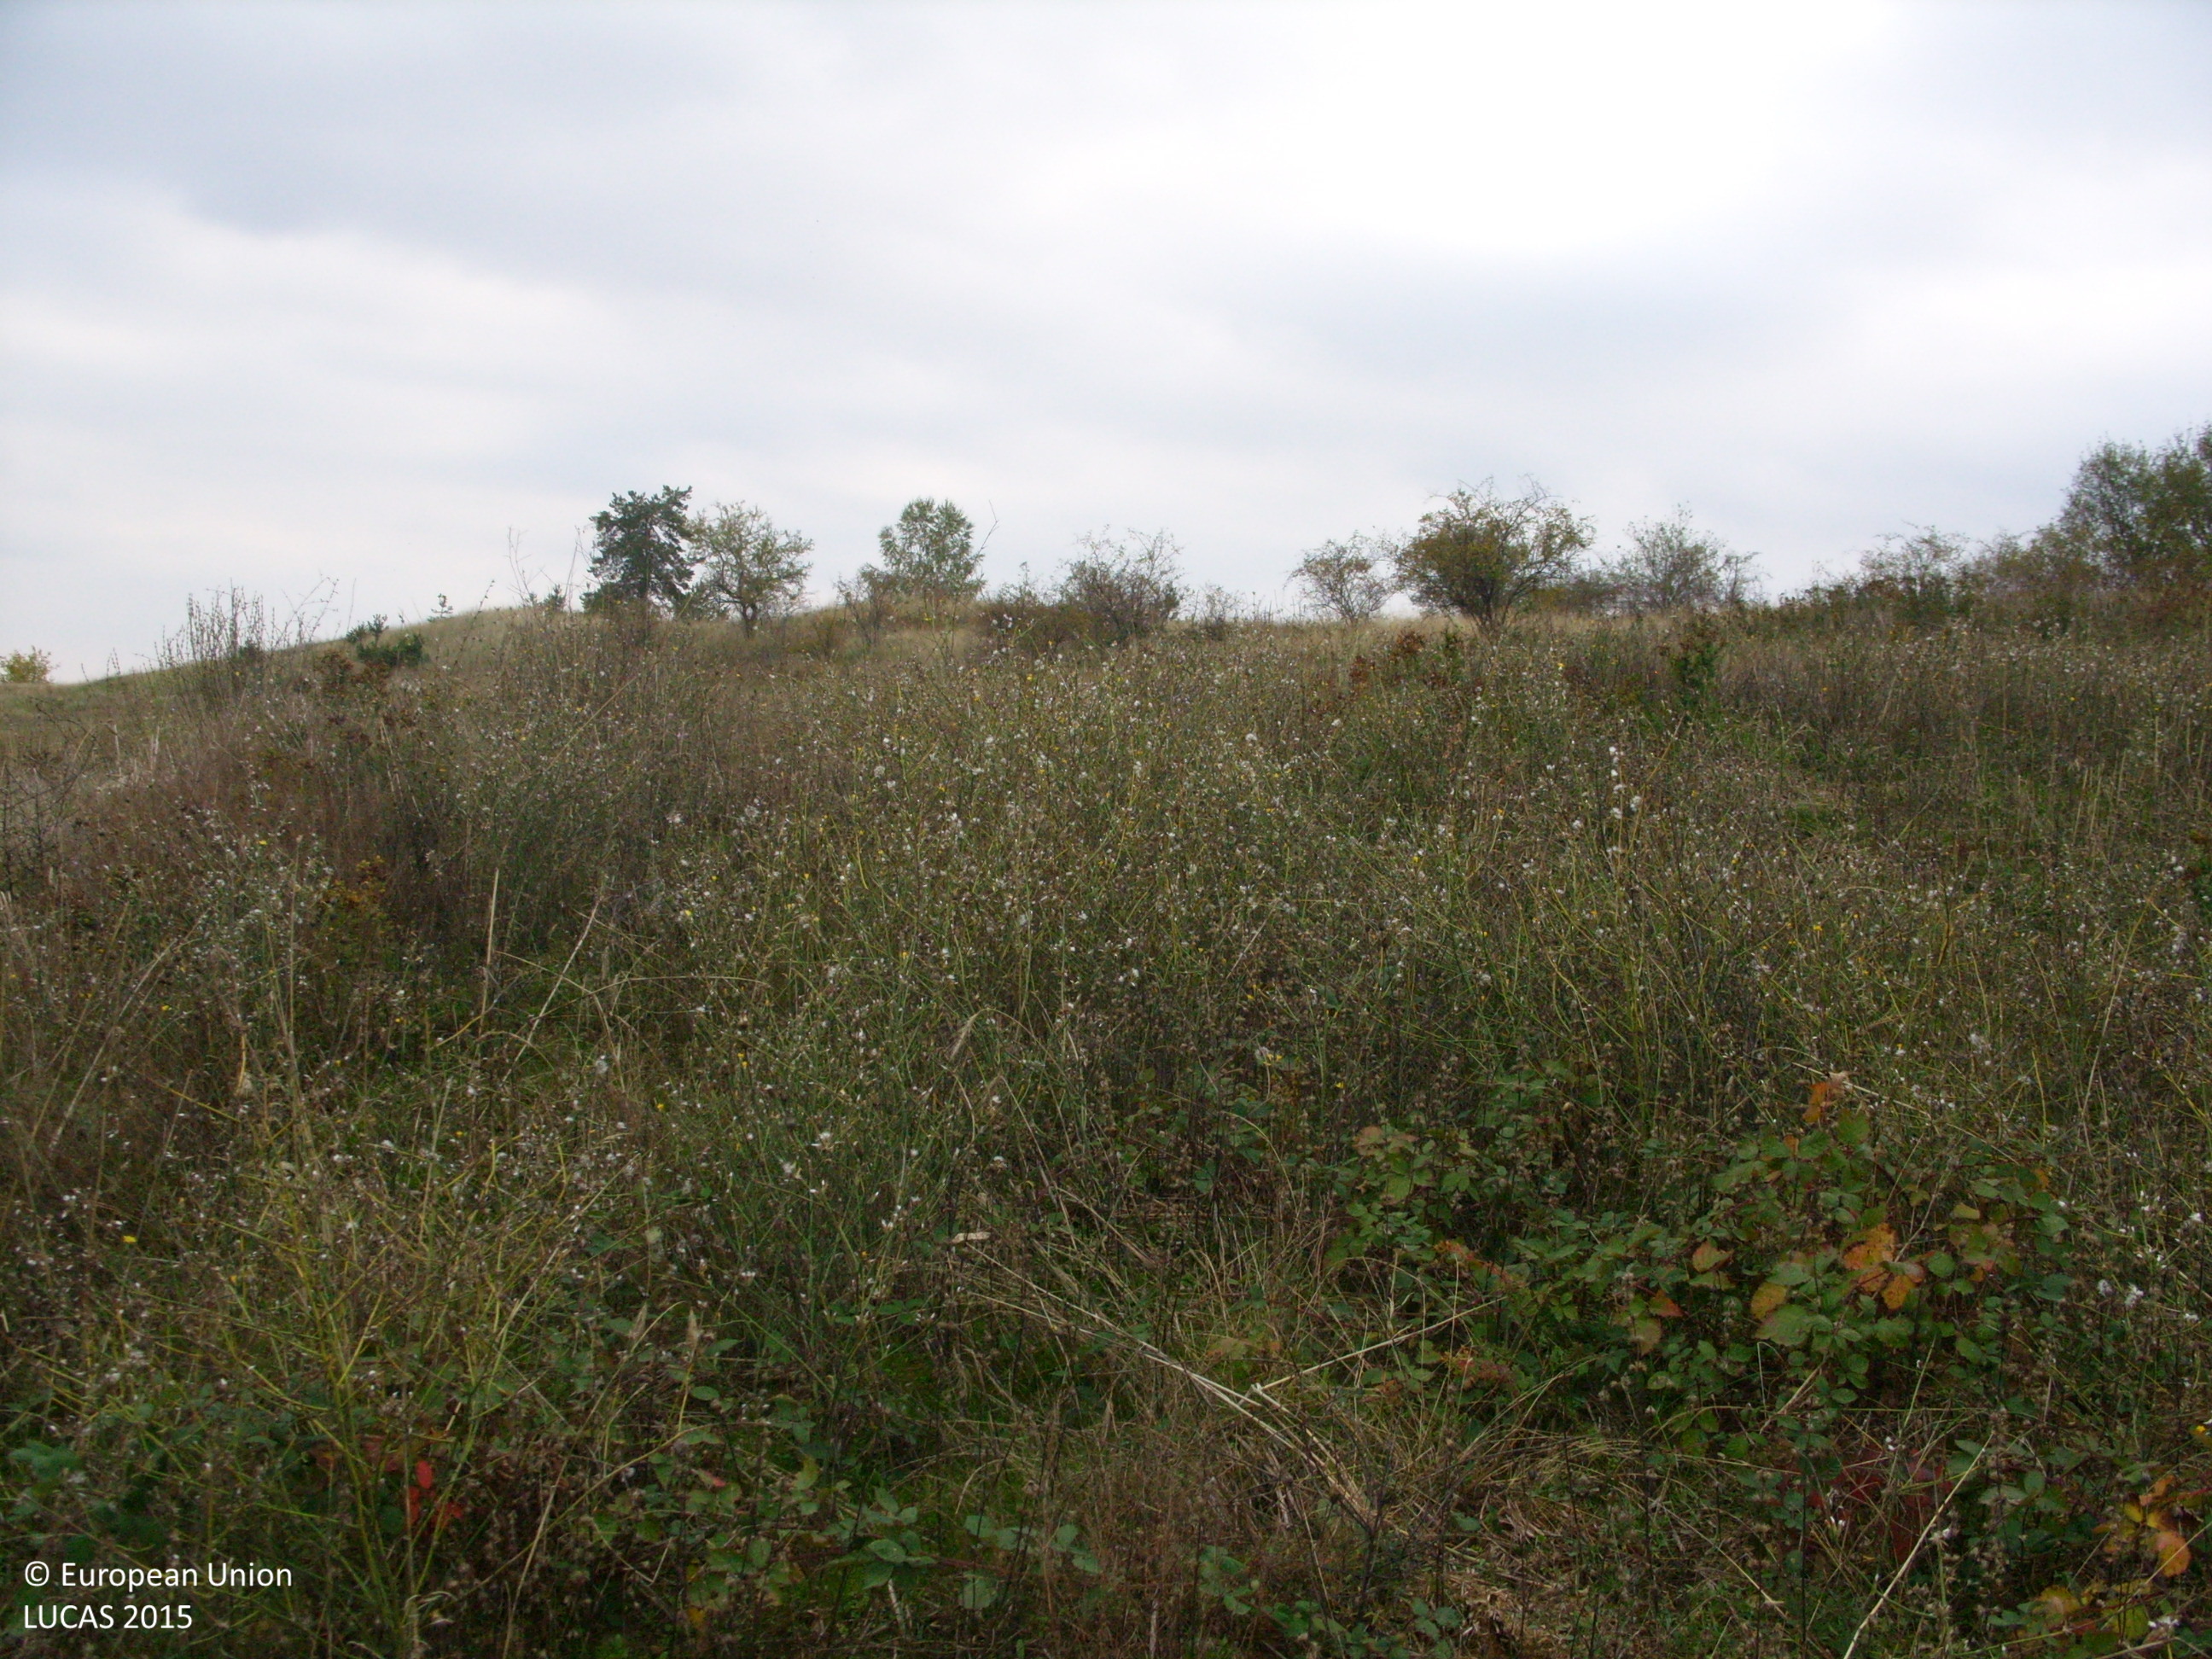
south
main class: Grassland
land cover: Spontaneously vegetated surfaces
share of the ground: > 75 %
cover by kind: herbaceous plants 100 %
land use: Agriculture (excluding fallow land and kitchen gardens)
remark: Harvested field
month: October
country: BG
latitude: 42.5613
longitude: 24.2126
